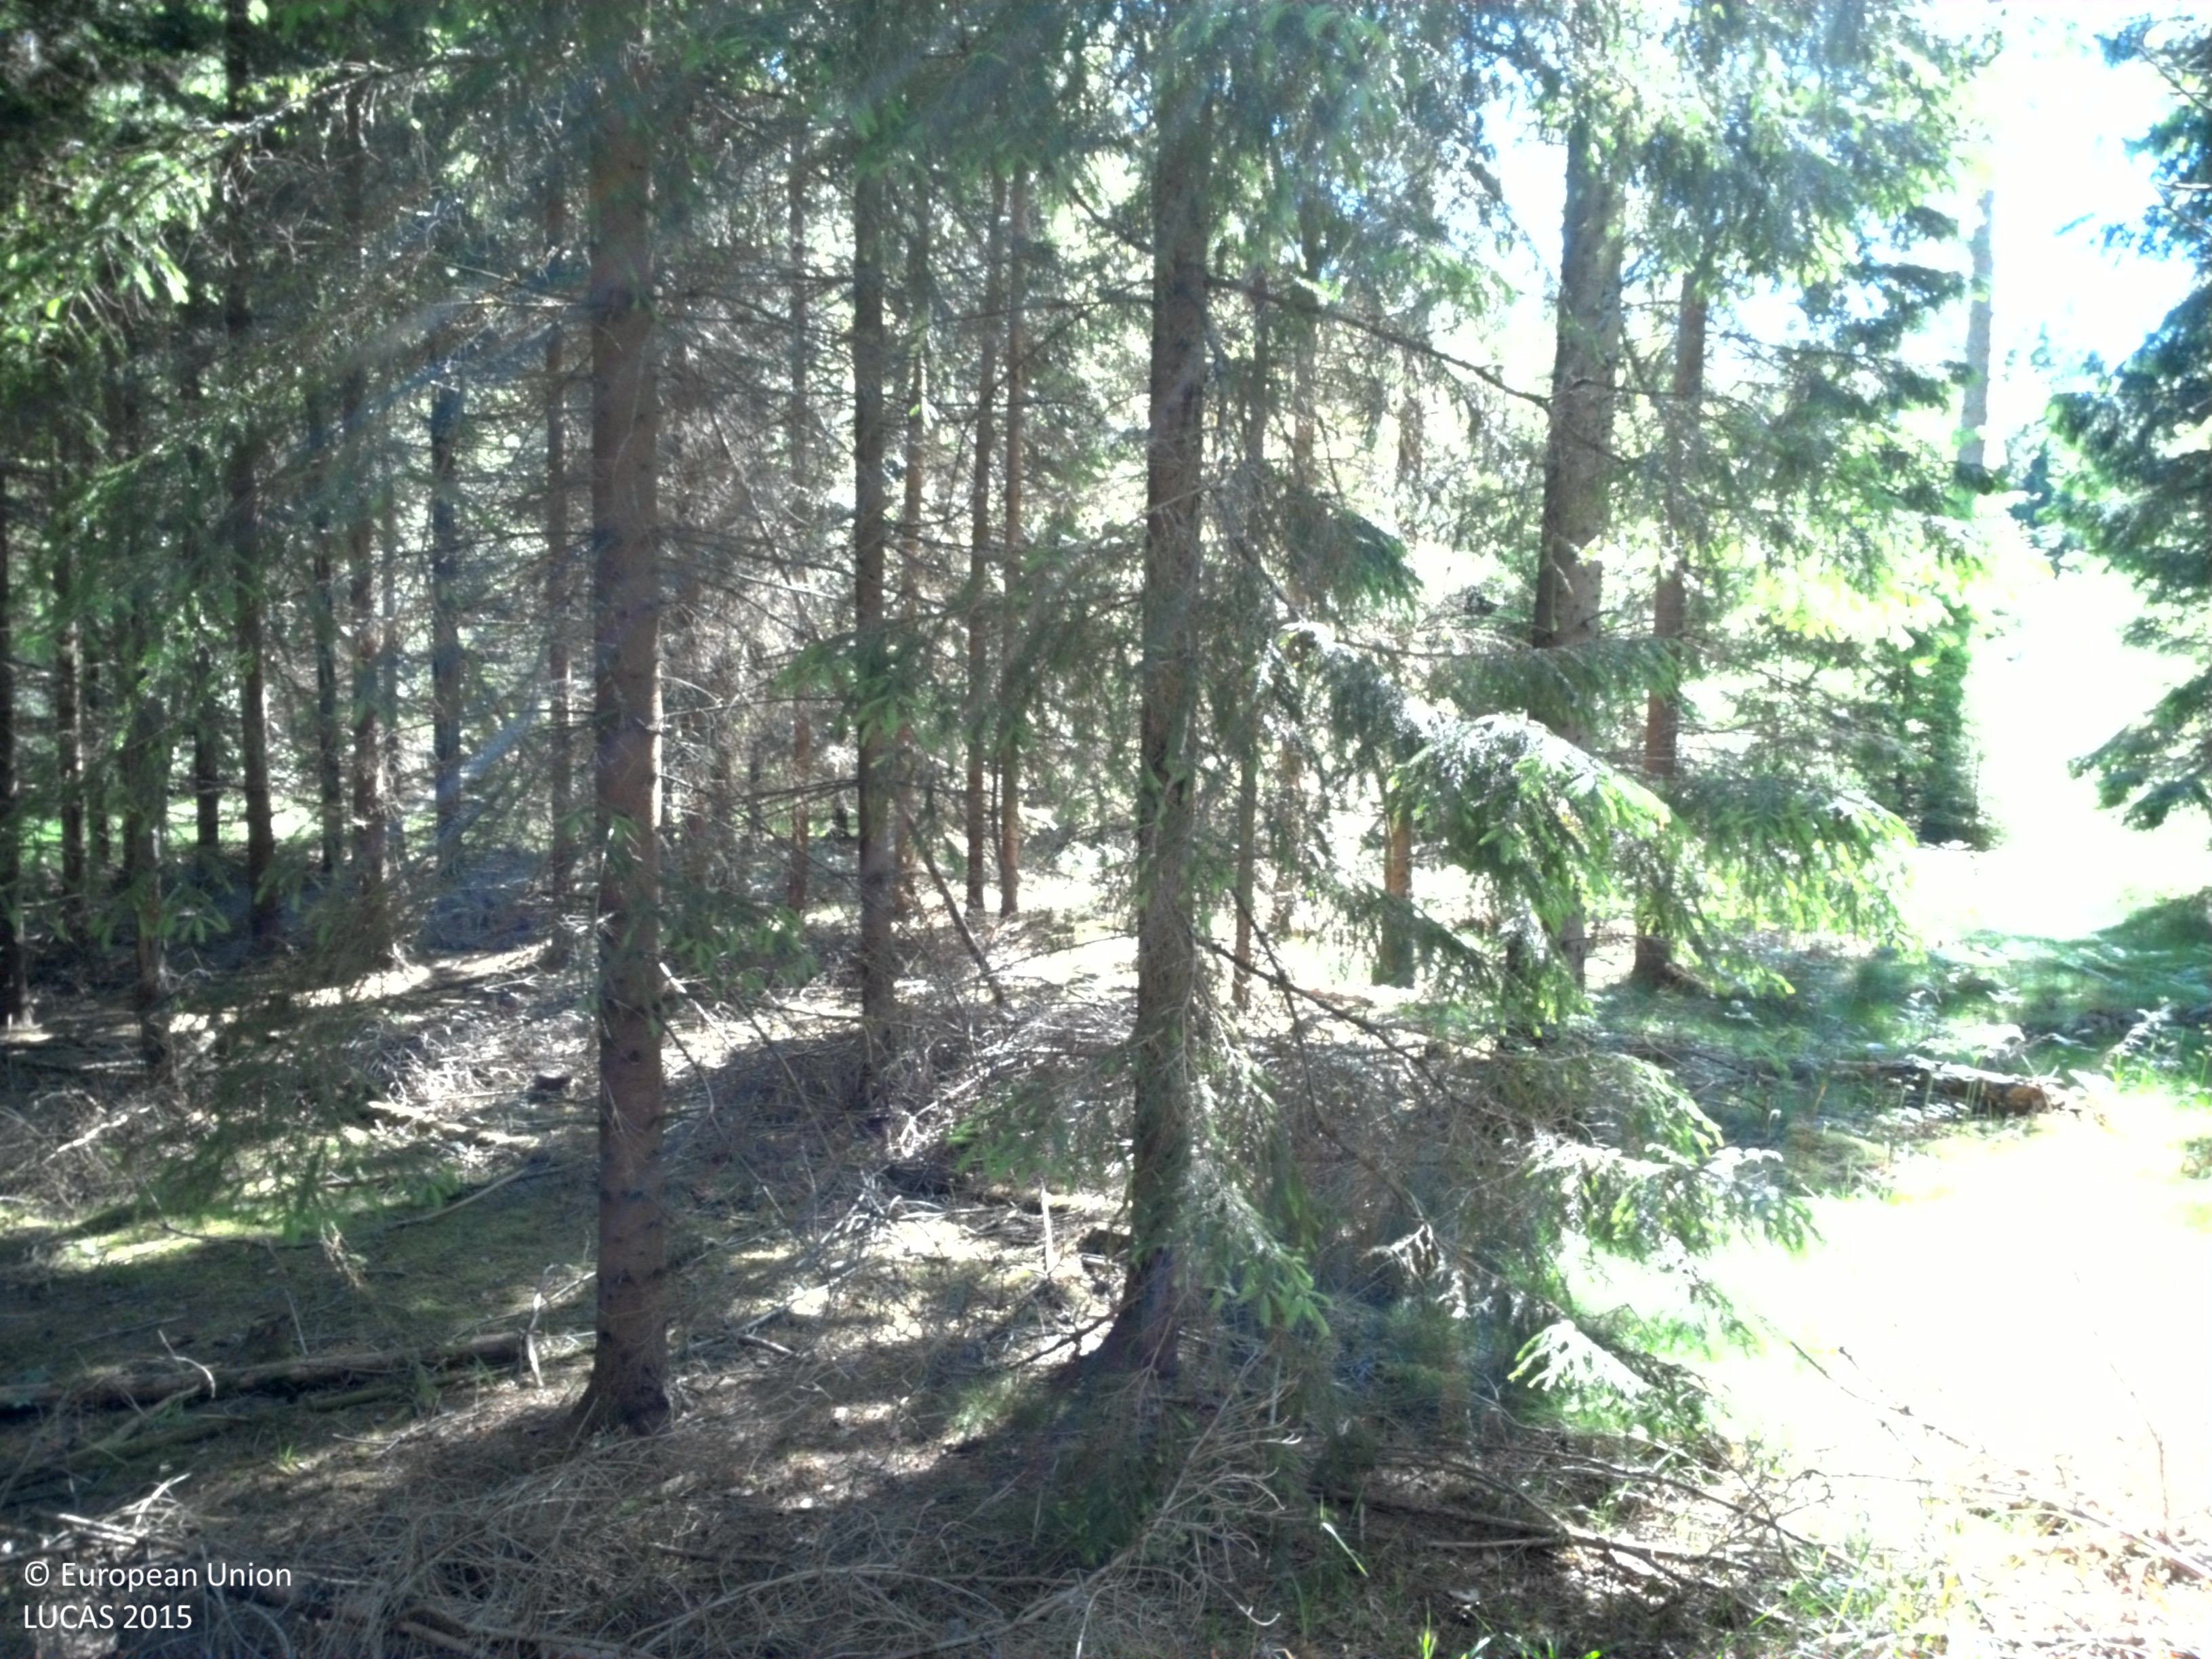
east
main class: Woodland
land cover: Other coniferous woodland
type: boreal forest
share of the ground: 25 - 50 %
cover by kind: coniferous forest trees 50 %, shrubs 25 %, herbaceous plants 10 %, lichens and mosses 10 %, broadleaved forest trees 5 %
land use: Forestry
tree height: > 5 m
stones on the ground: 10 - 25 %
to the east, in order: Other coniferous woodland; Tracks; Spruce dominated coniferous woodland; Spruce dominated mixed woodland; Ditches and canals; Spruce dominated mixed woodland; Tracks; Spruce dominated mixed woodland; Spruce dominated coniferous woodland; Grass margins; Paved roads, cycling and walking lanes; Grass margins; Spruce dominated coniferous woodland; Spruce dominated mixed woodland
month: June
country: SE
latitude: 58.6850
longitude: 14.4953
